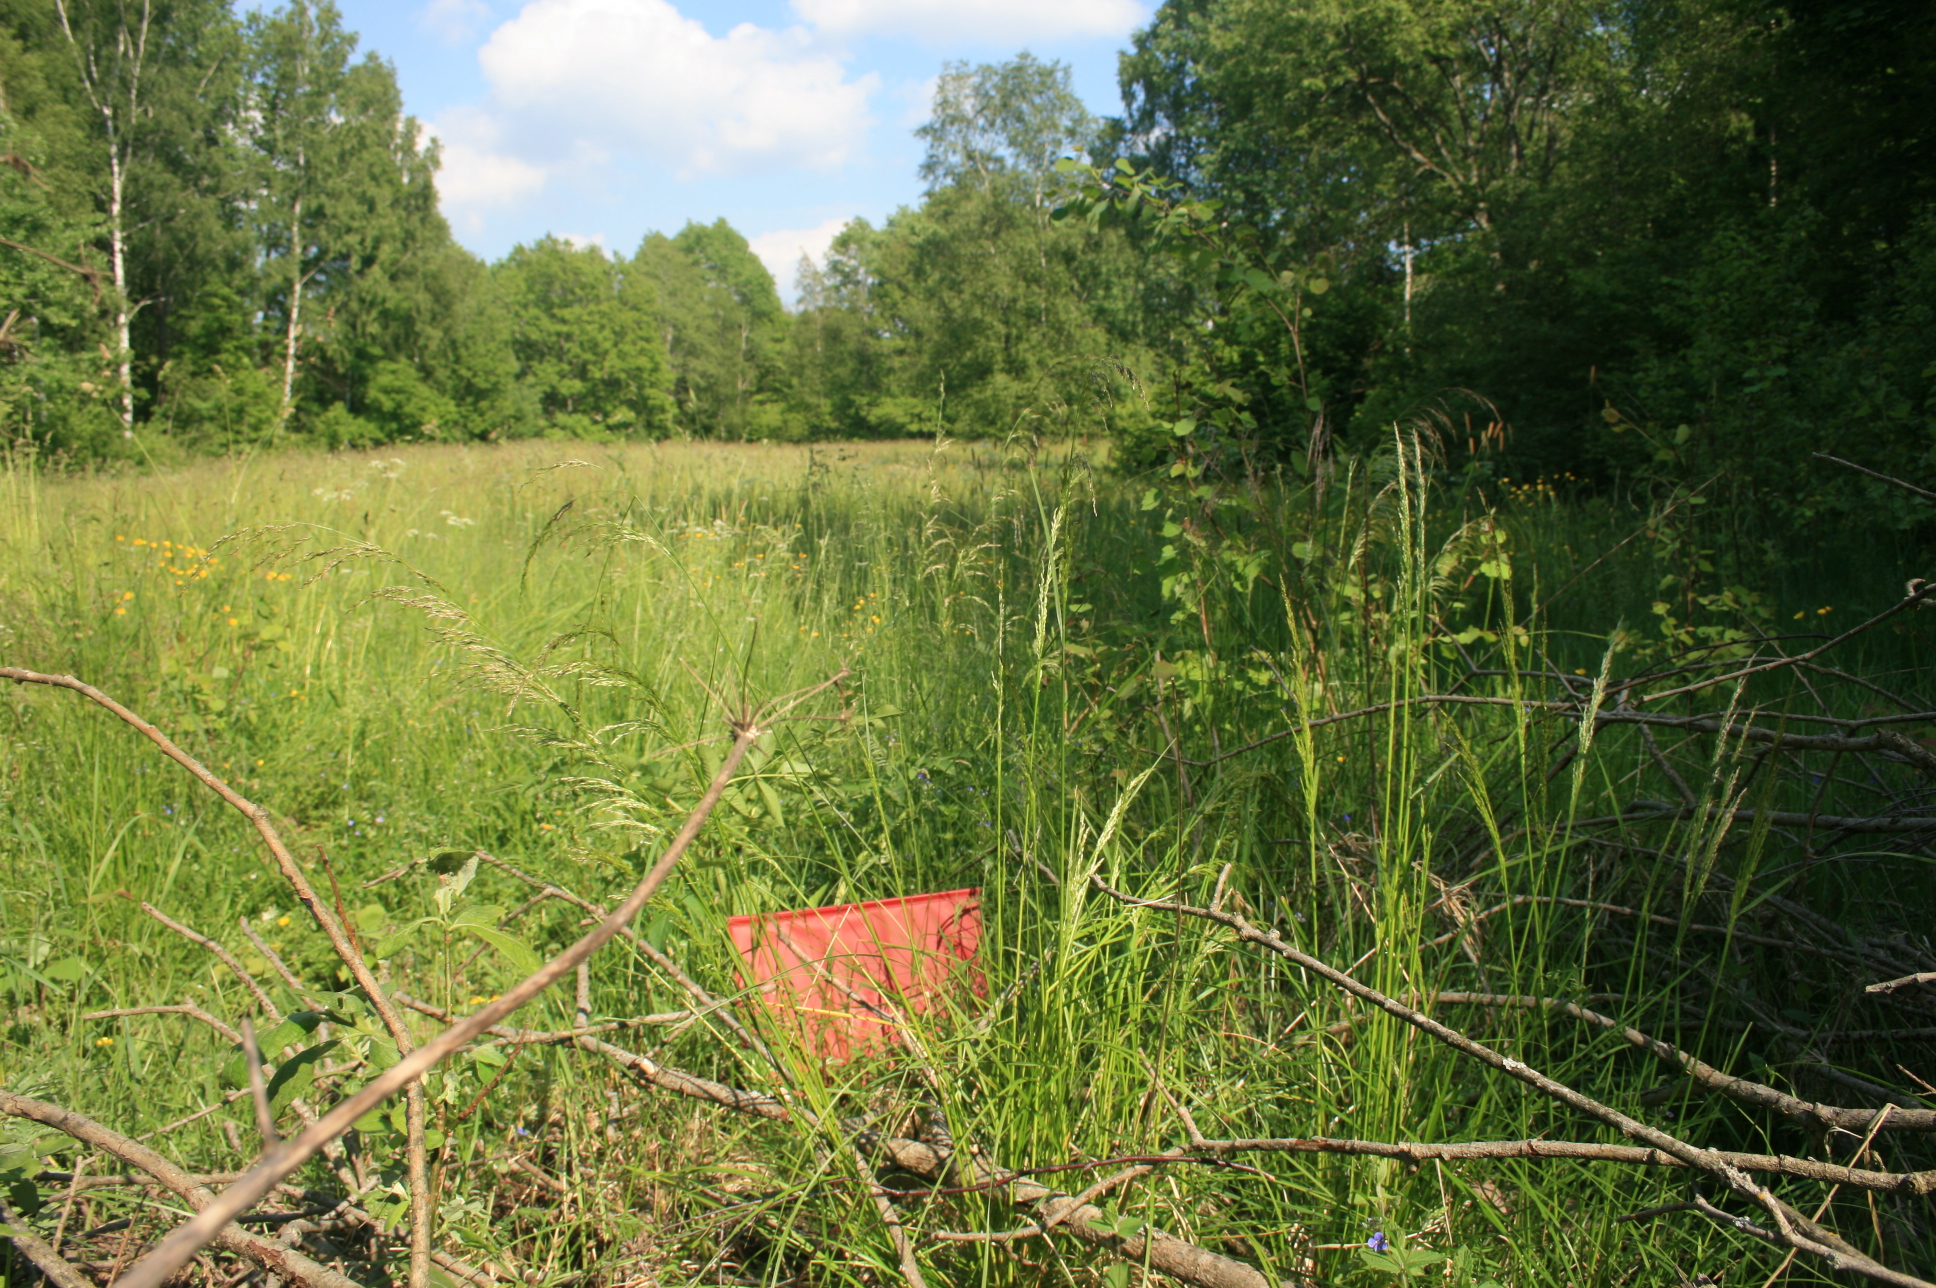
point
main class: Grassland
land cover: Grassland without tree/shrub cover
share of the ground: > 75 %
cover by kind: herbaceous plants 100 %
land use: Agriculture (excluding fallow land and kitchen gardens)
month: June
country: LT
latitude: 55.5885
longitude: 22.1613
